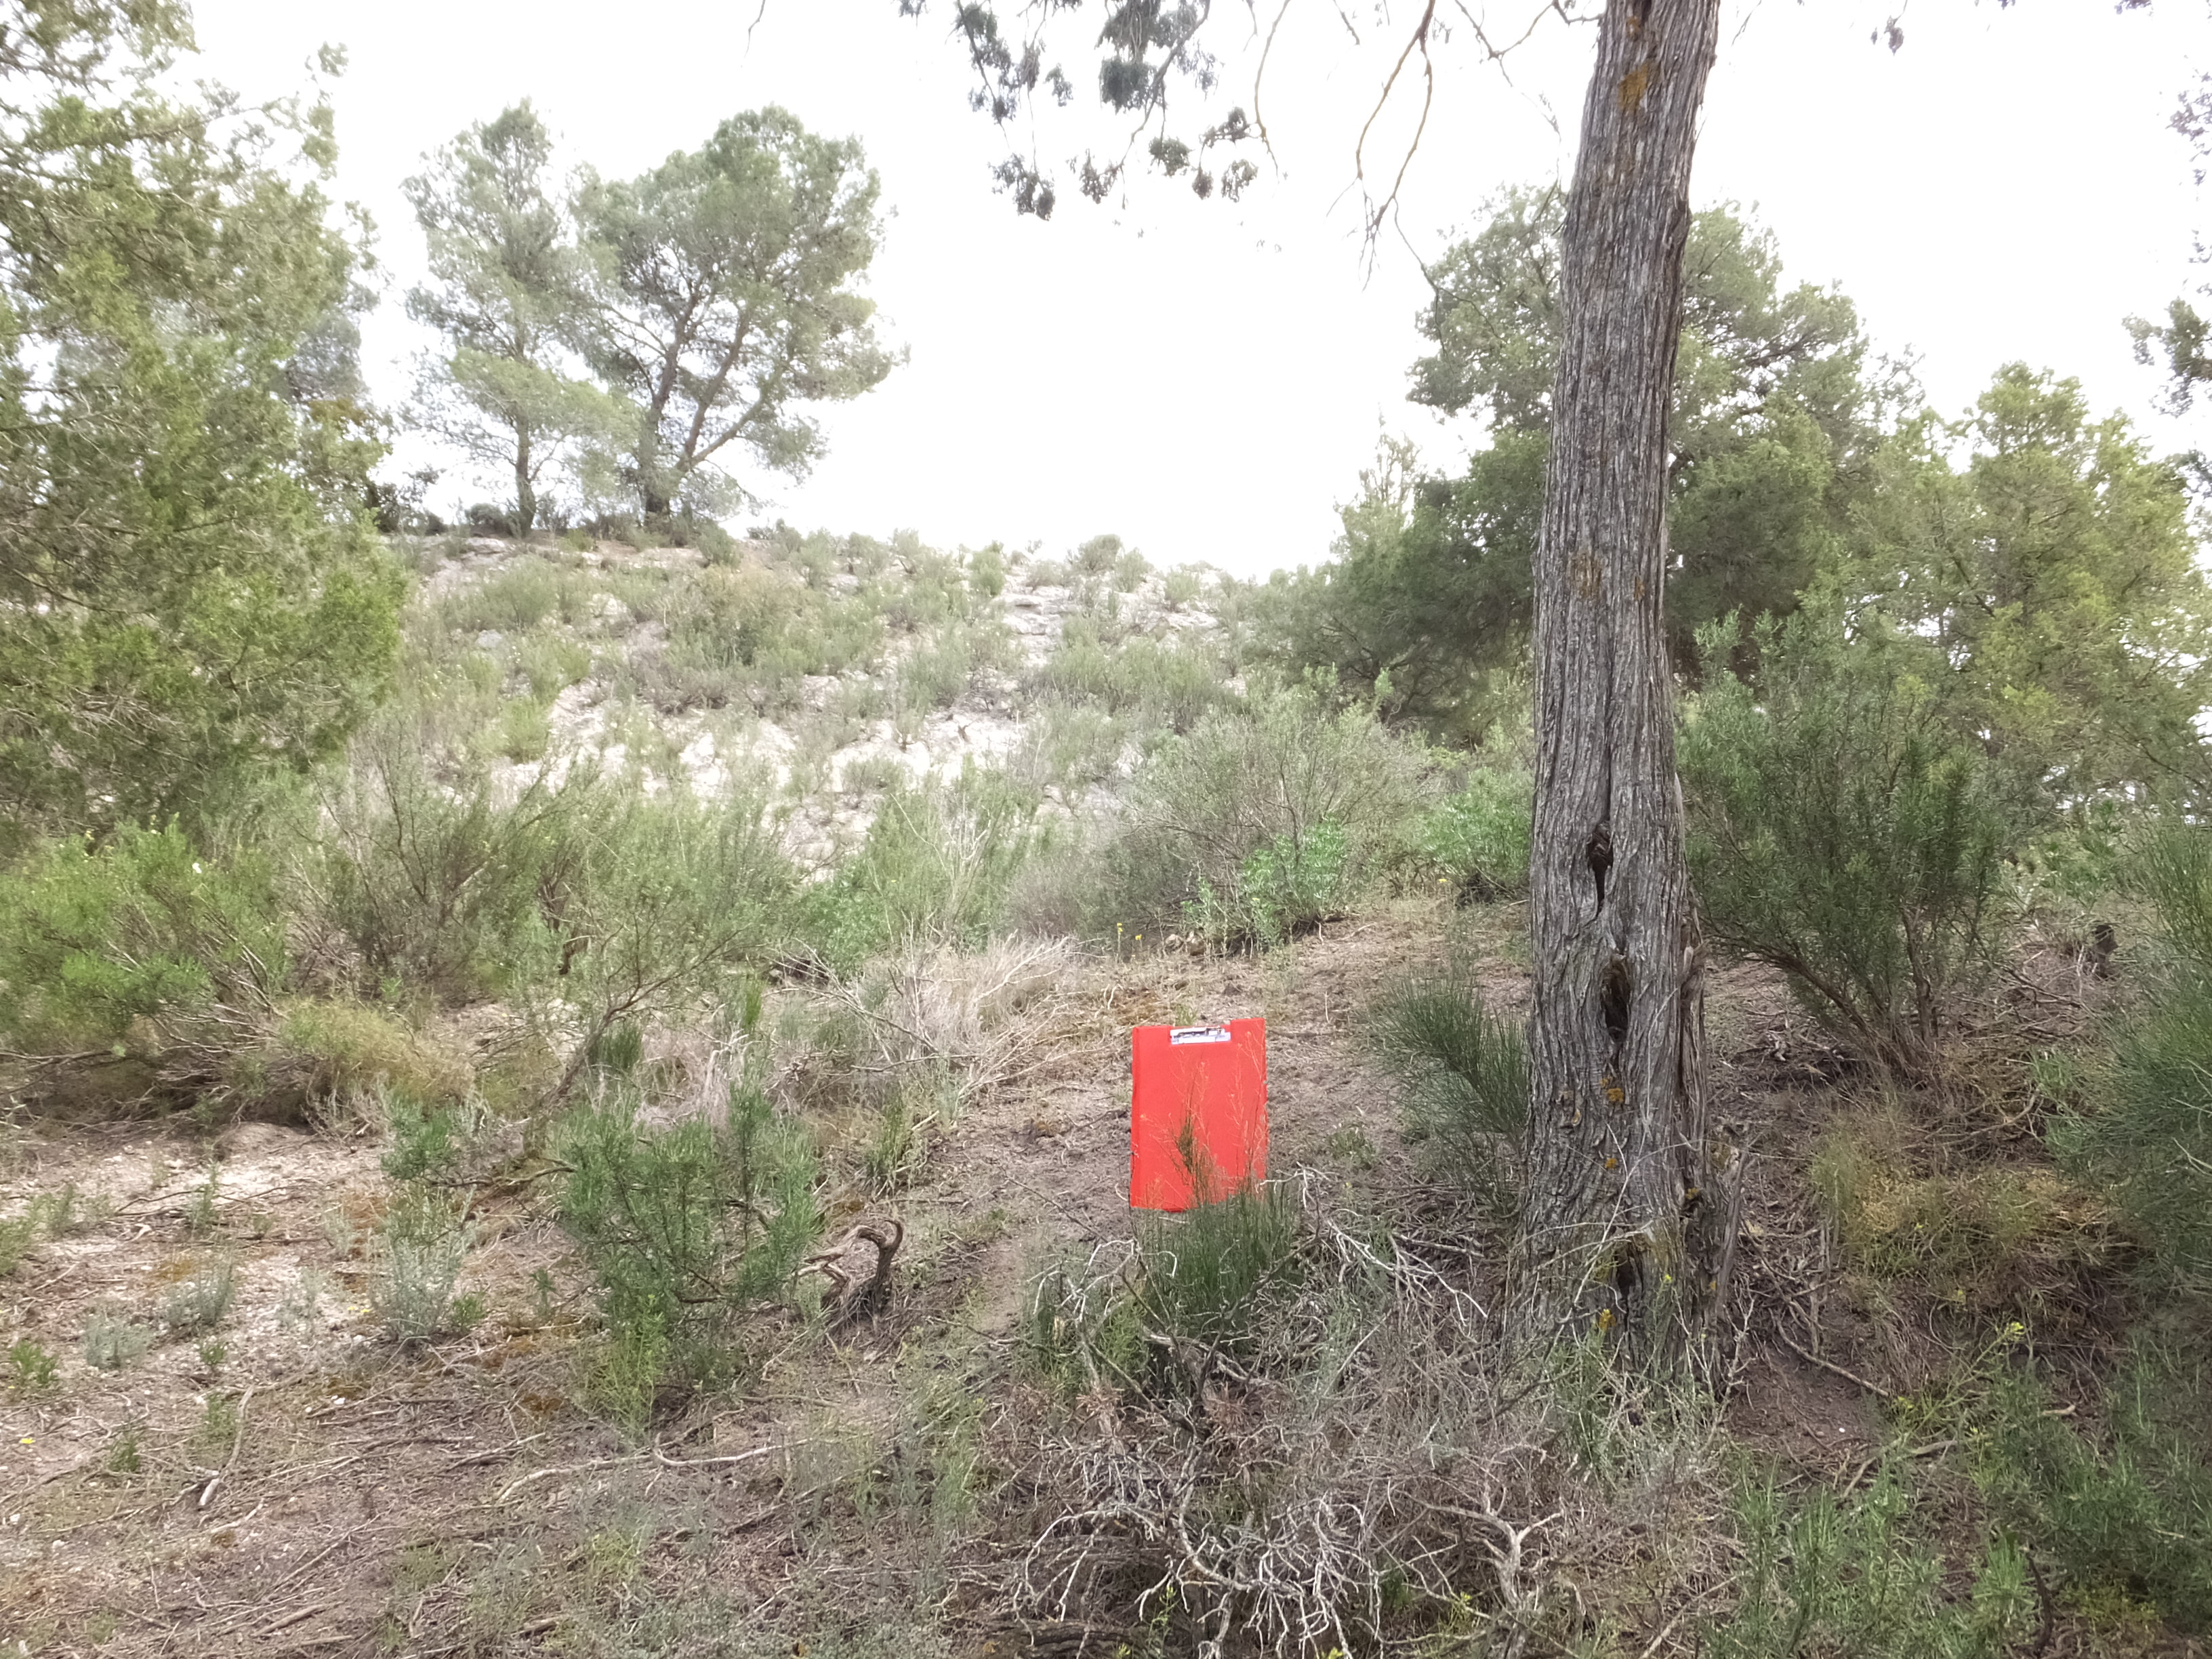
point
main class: Woodland
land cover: Pine dominated mixed woodland
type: coniferous forest of the mediterranean region
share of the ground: 50 - 75 %
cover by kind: coniferous forest trees 60 %, broadleaved forest trees 20 %, shrubs 20 %
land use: Forestry
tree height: > 5 m
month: May
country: ES
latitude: 41.4747
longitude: -0.2784
